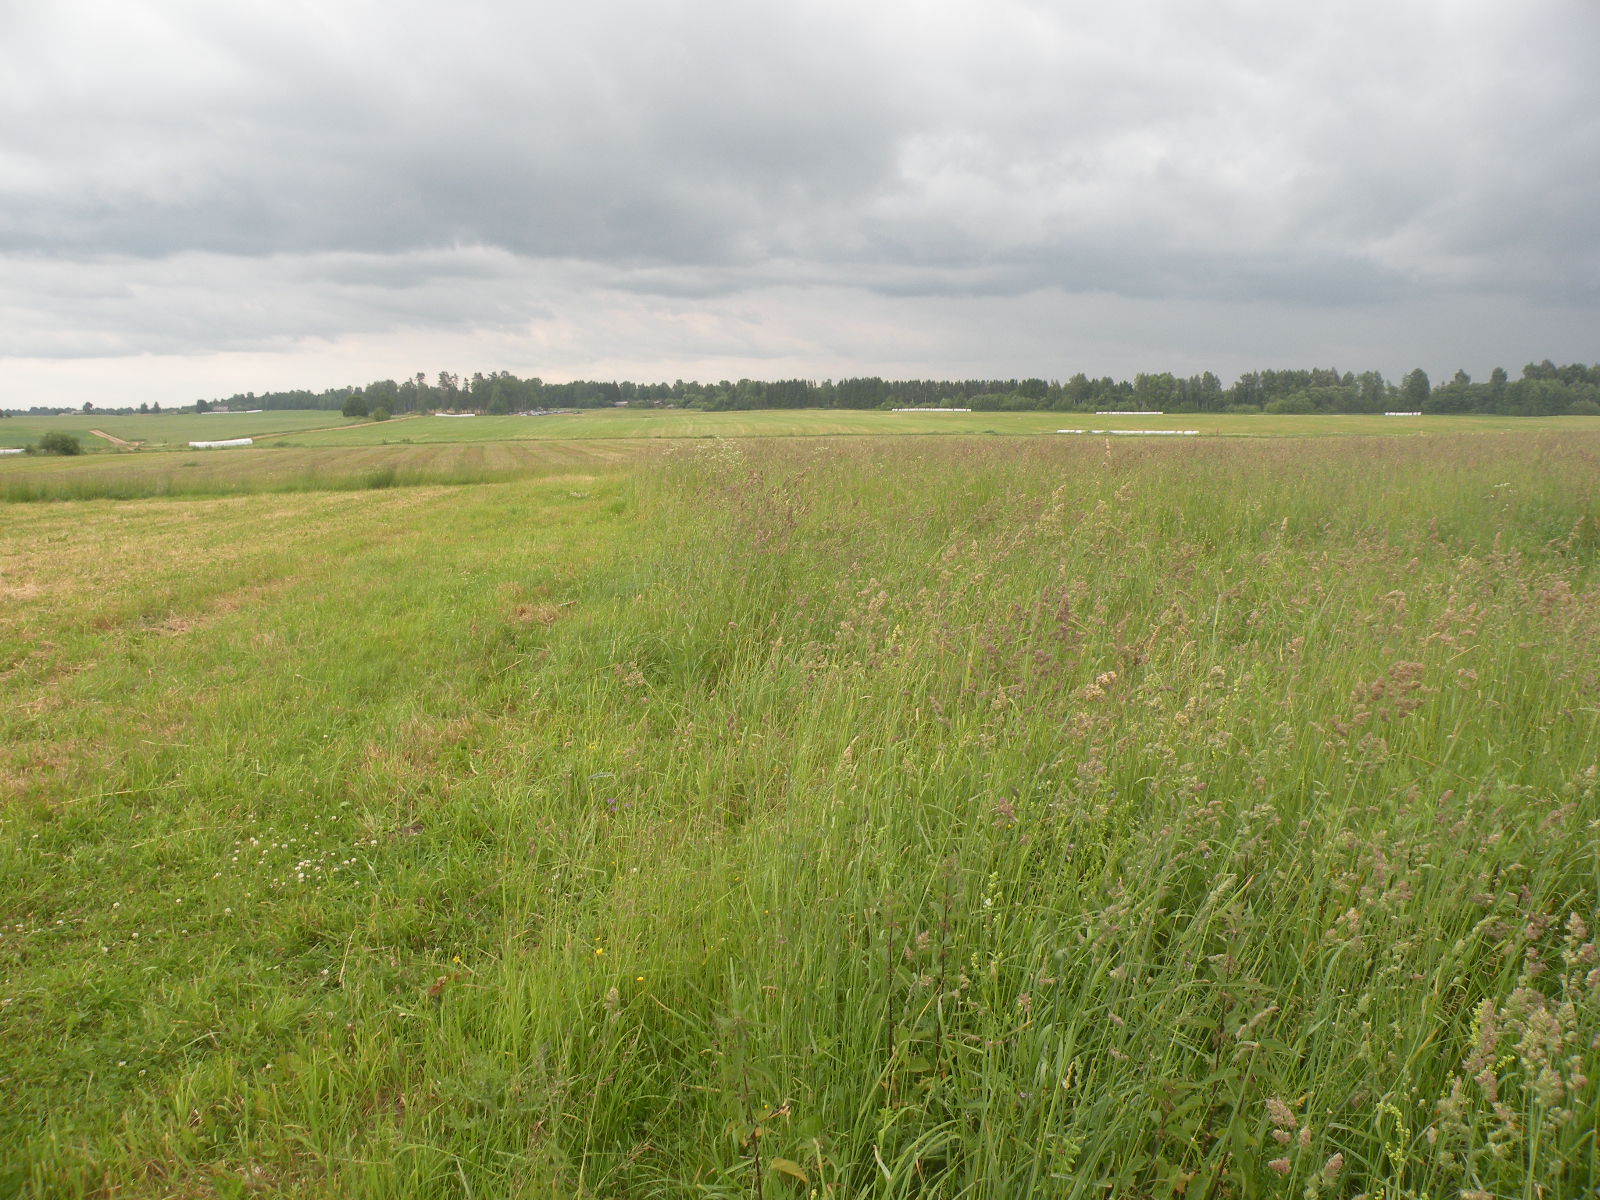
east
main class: Grassland
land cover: Grassland without tree/shrub cover
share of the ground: > 75 %
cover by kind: herbaceous plants 100 %
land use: Agriculture (excluding fallow land and kitchen gardens)
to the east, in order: Grassland without tree/shrub cover
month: June
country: LV
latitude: 56.0425
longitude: 26.6730
